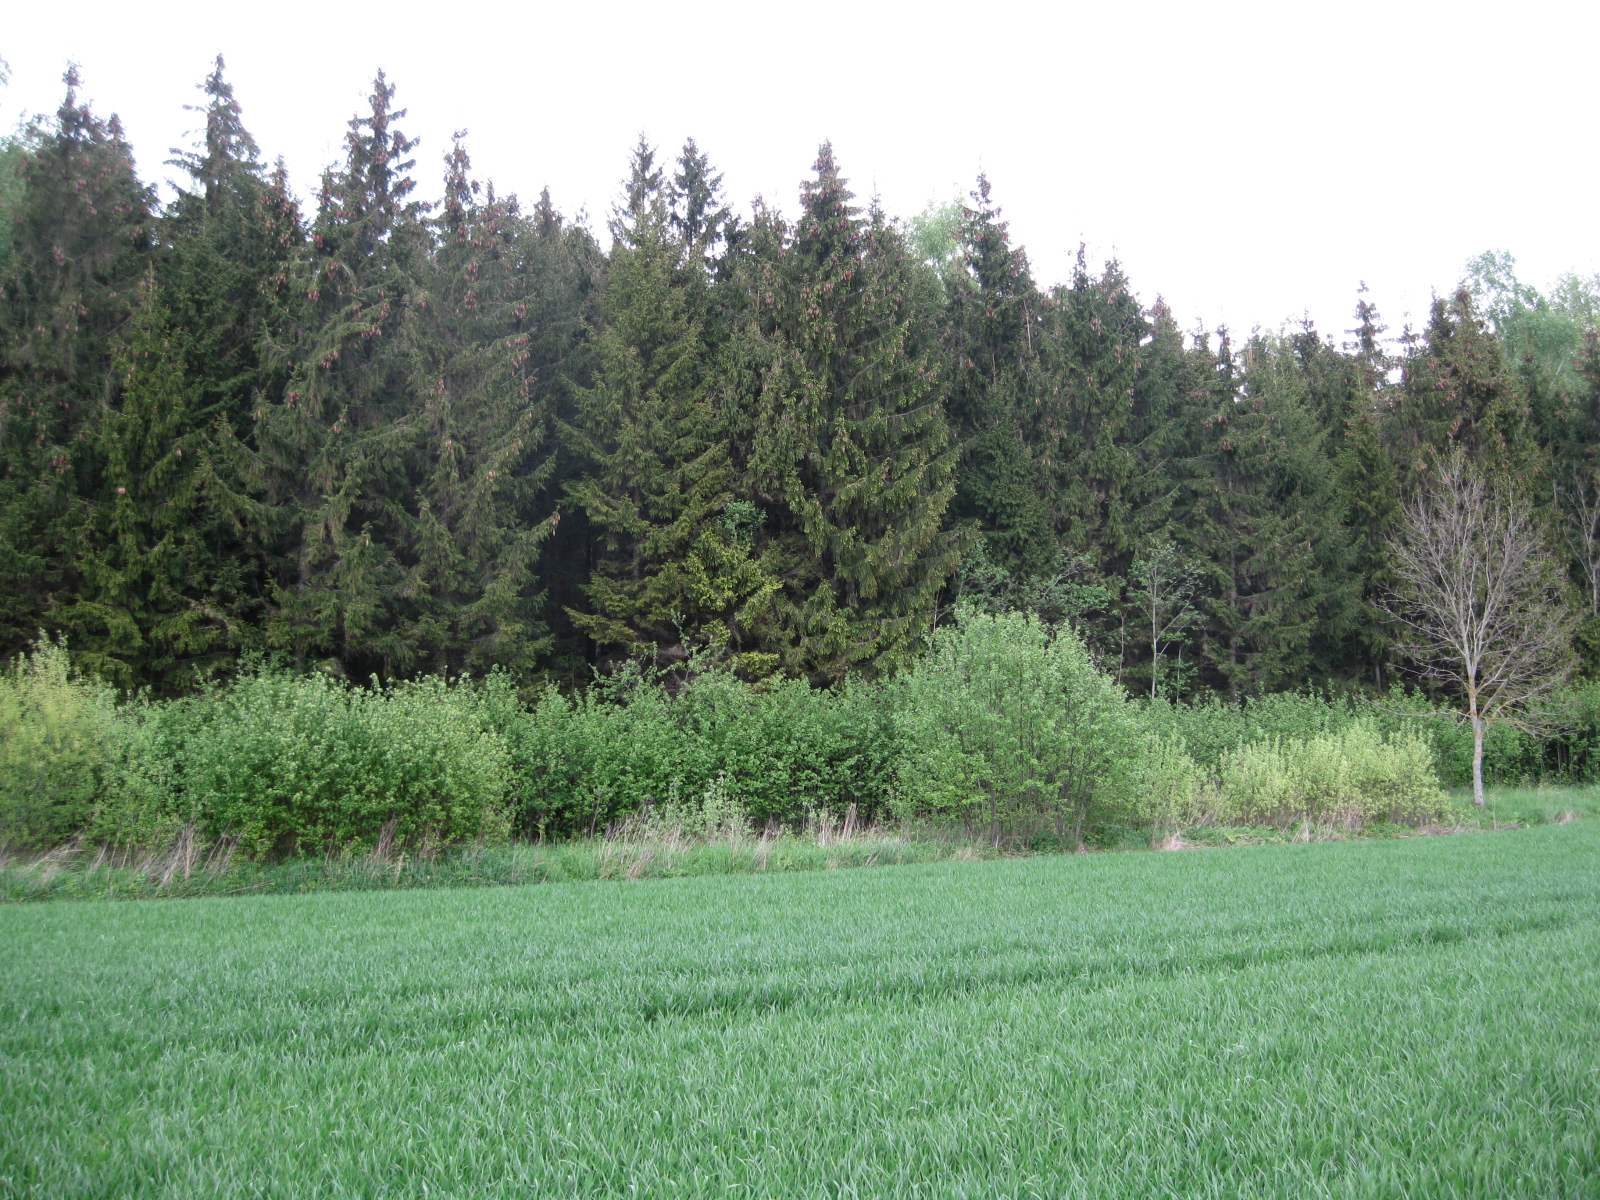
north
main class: Cropland
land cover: Common wheat
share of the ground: > 75 %
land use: Agriculture (excluding fallow land and kitchen gardens)
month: May
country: LT
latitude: 56.2311
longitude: 23.3822
